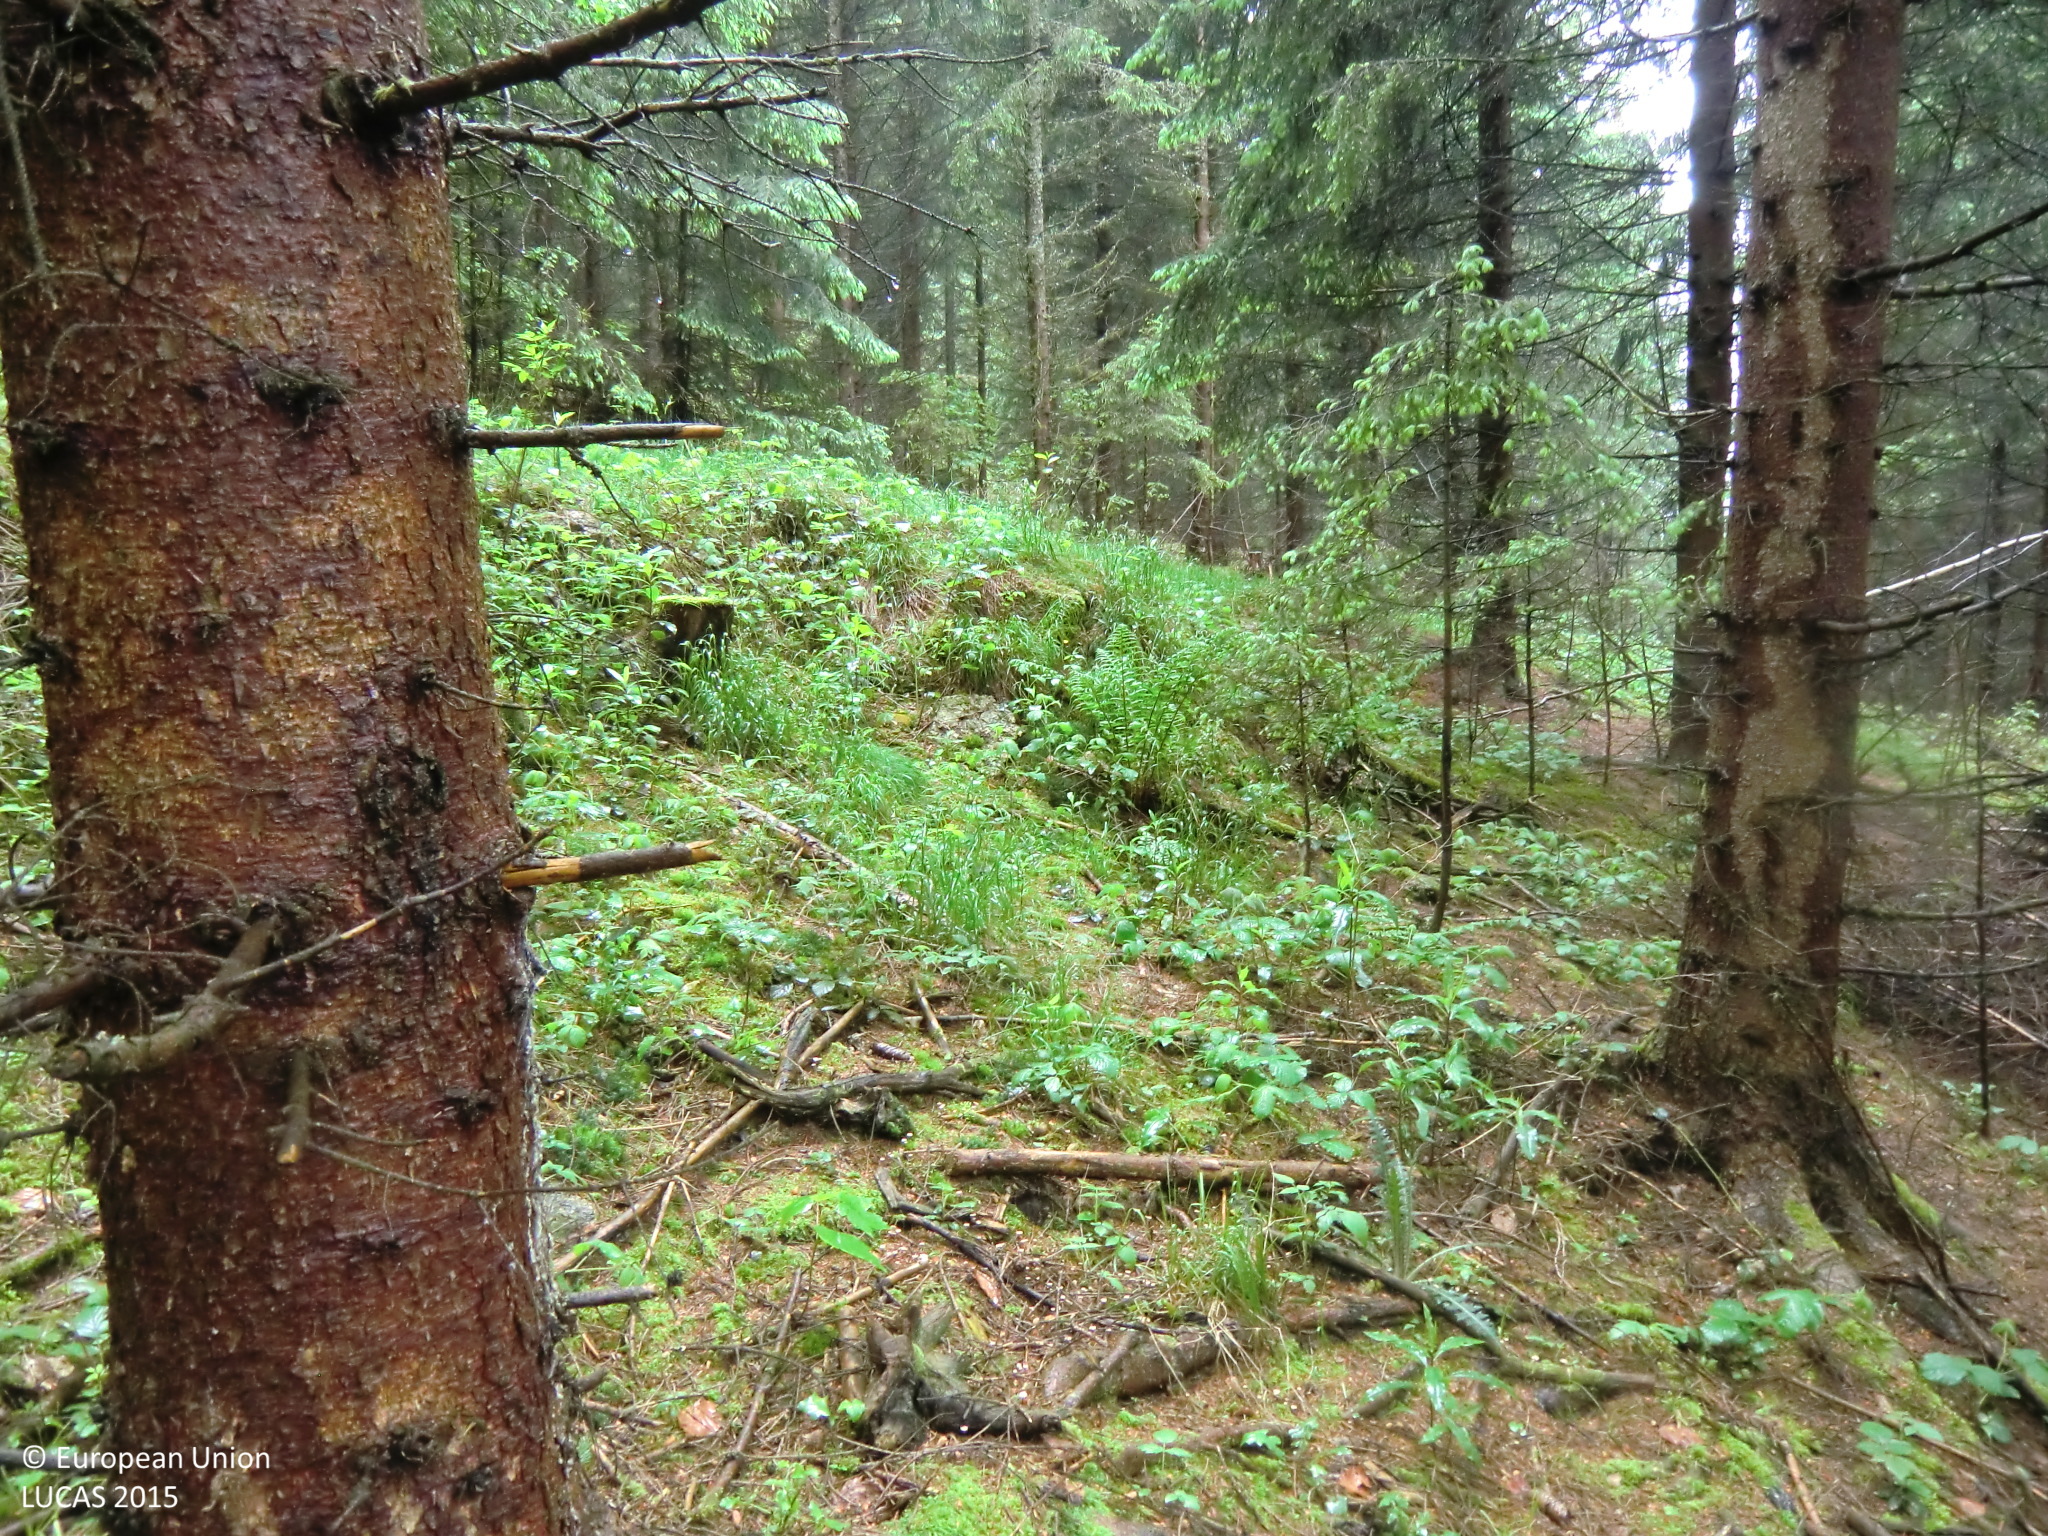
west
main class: Woodland
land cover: Spruce dominated coniferous woodland
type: hemiboreal forest and nemoral coniferous forest and mixed broadleaved-coniferous forest
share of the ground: > 75 %
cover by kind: coniferous forest trees 75 %, herbaceous plants 10 %, lichens and mosses 10 %, unconsolidated bare surface 5 %
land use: Forestry
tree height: > 5 m
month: May
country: AT
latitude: 48.3728
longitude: 14.7665
